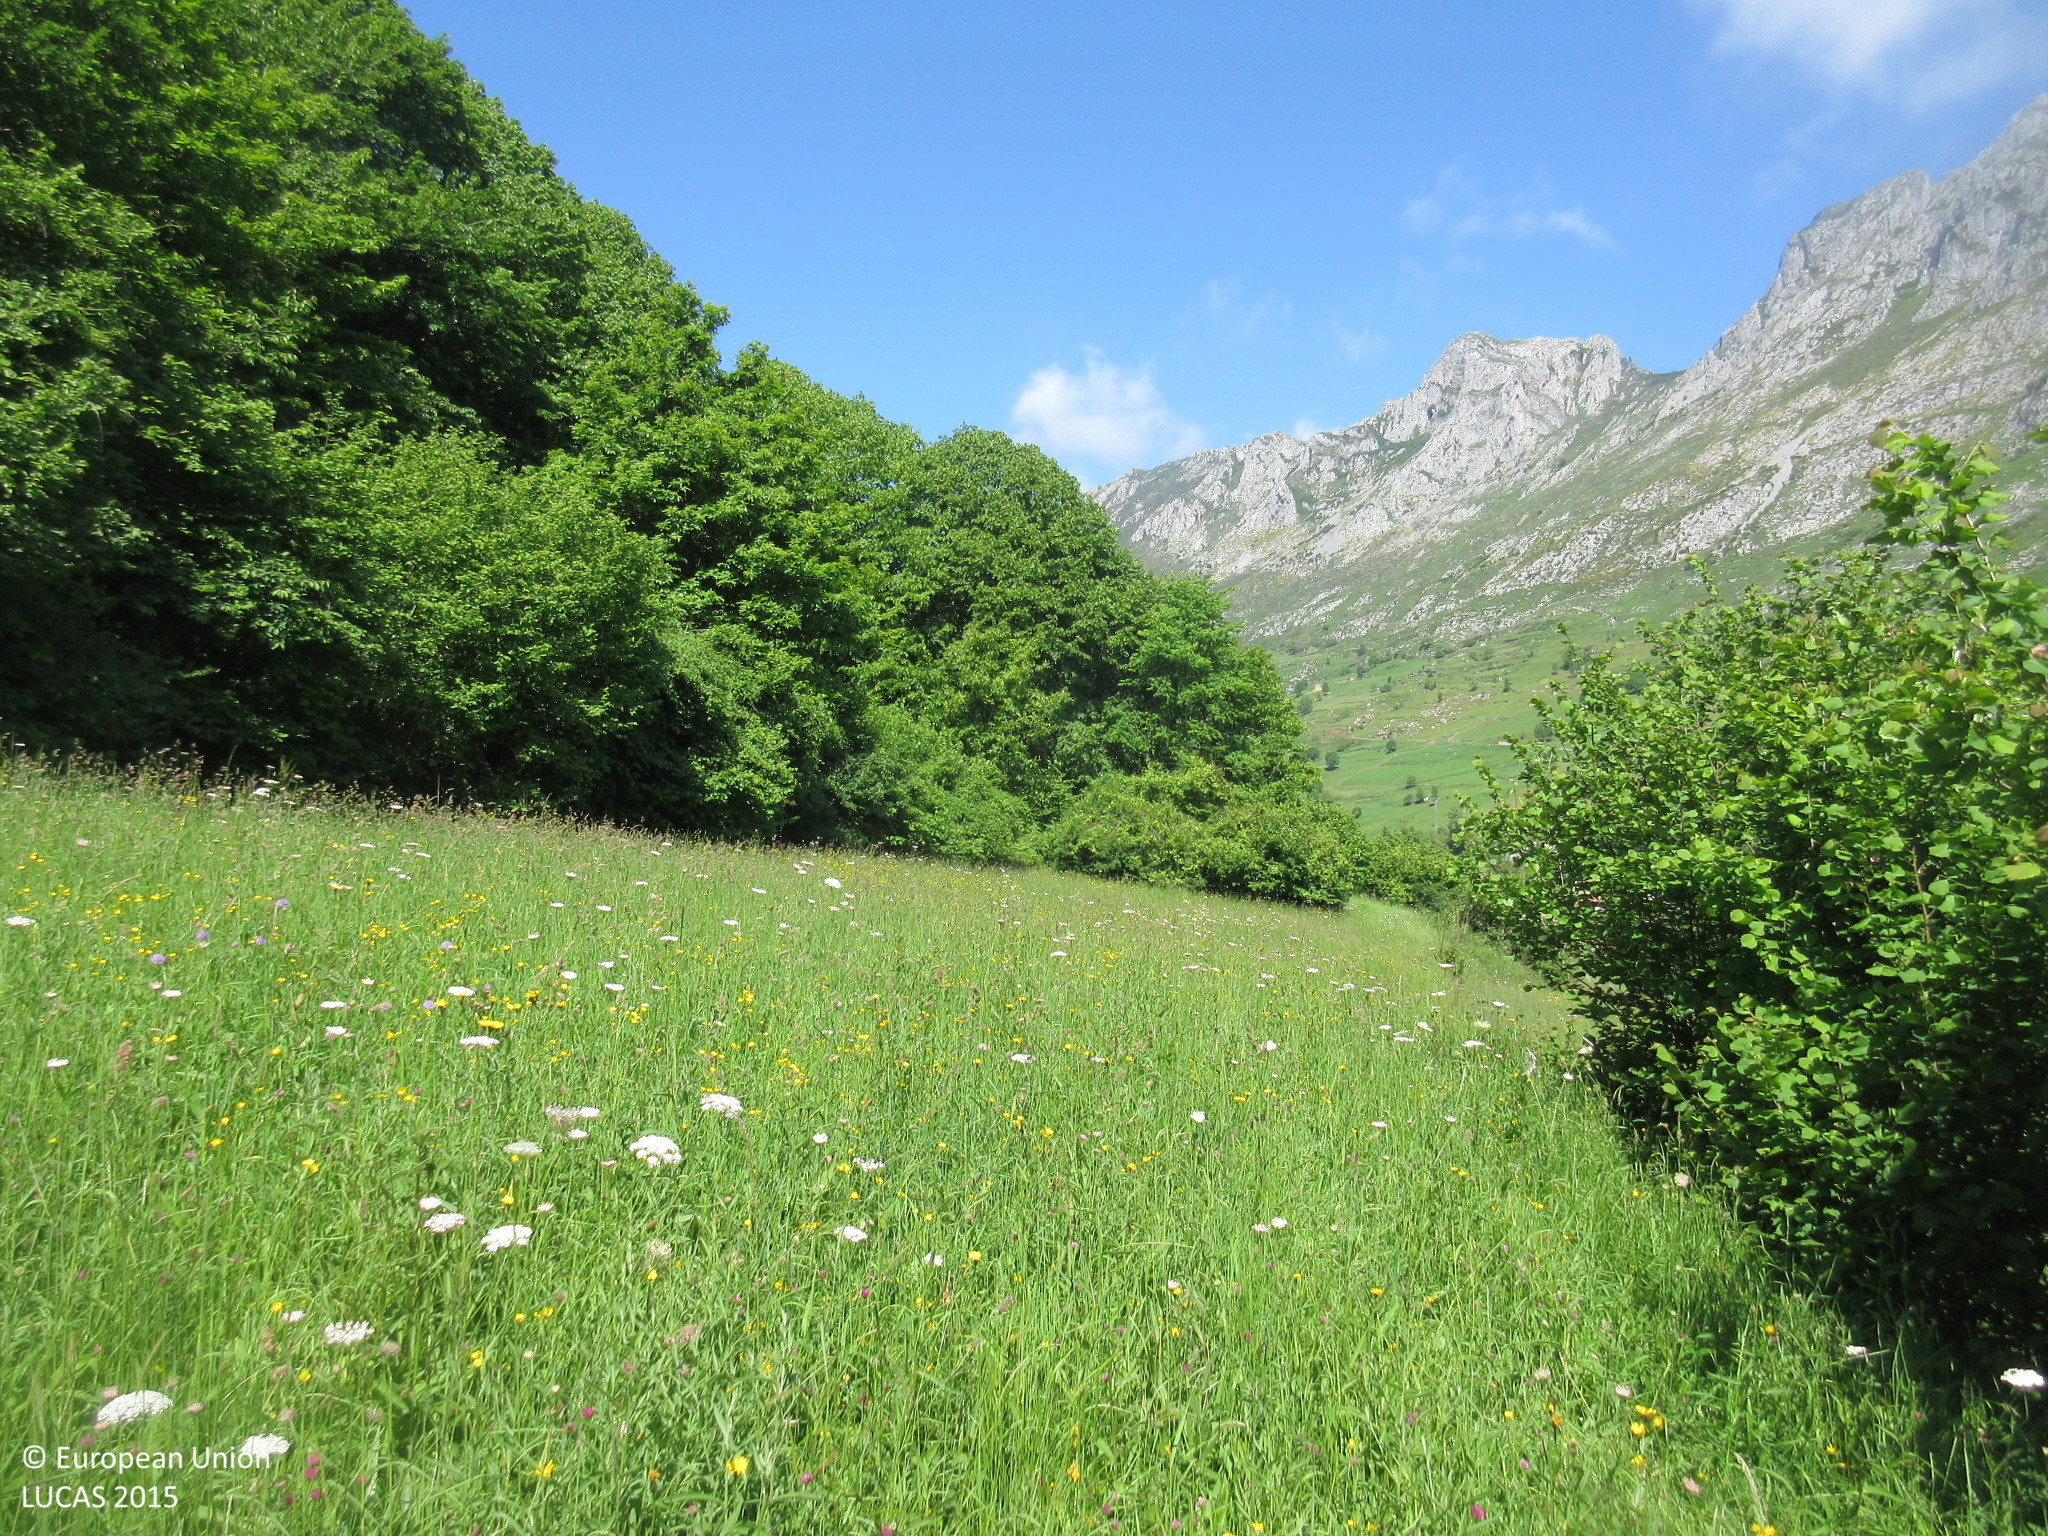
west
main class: Grassland
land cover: Grassland without tree/shrub cover
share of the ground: > 75 %
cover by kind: herbaceous plants 100 %
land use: Agriculture (excluding fallow land and kitchen gardens)
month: May
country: ES
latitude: 43.2515
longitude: -4.5072
